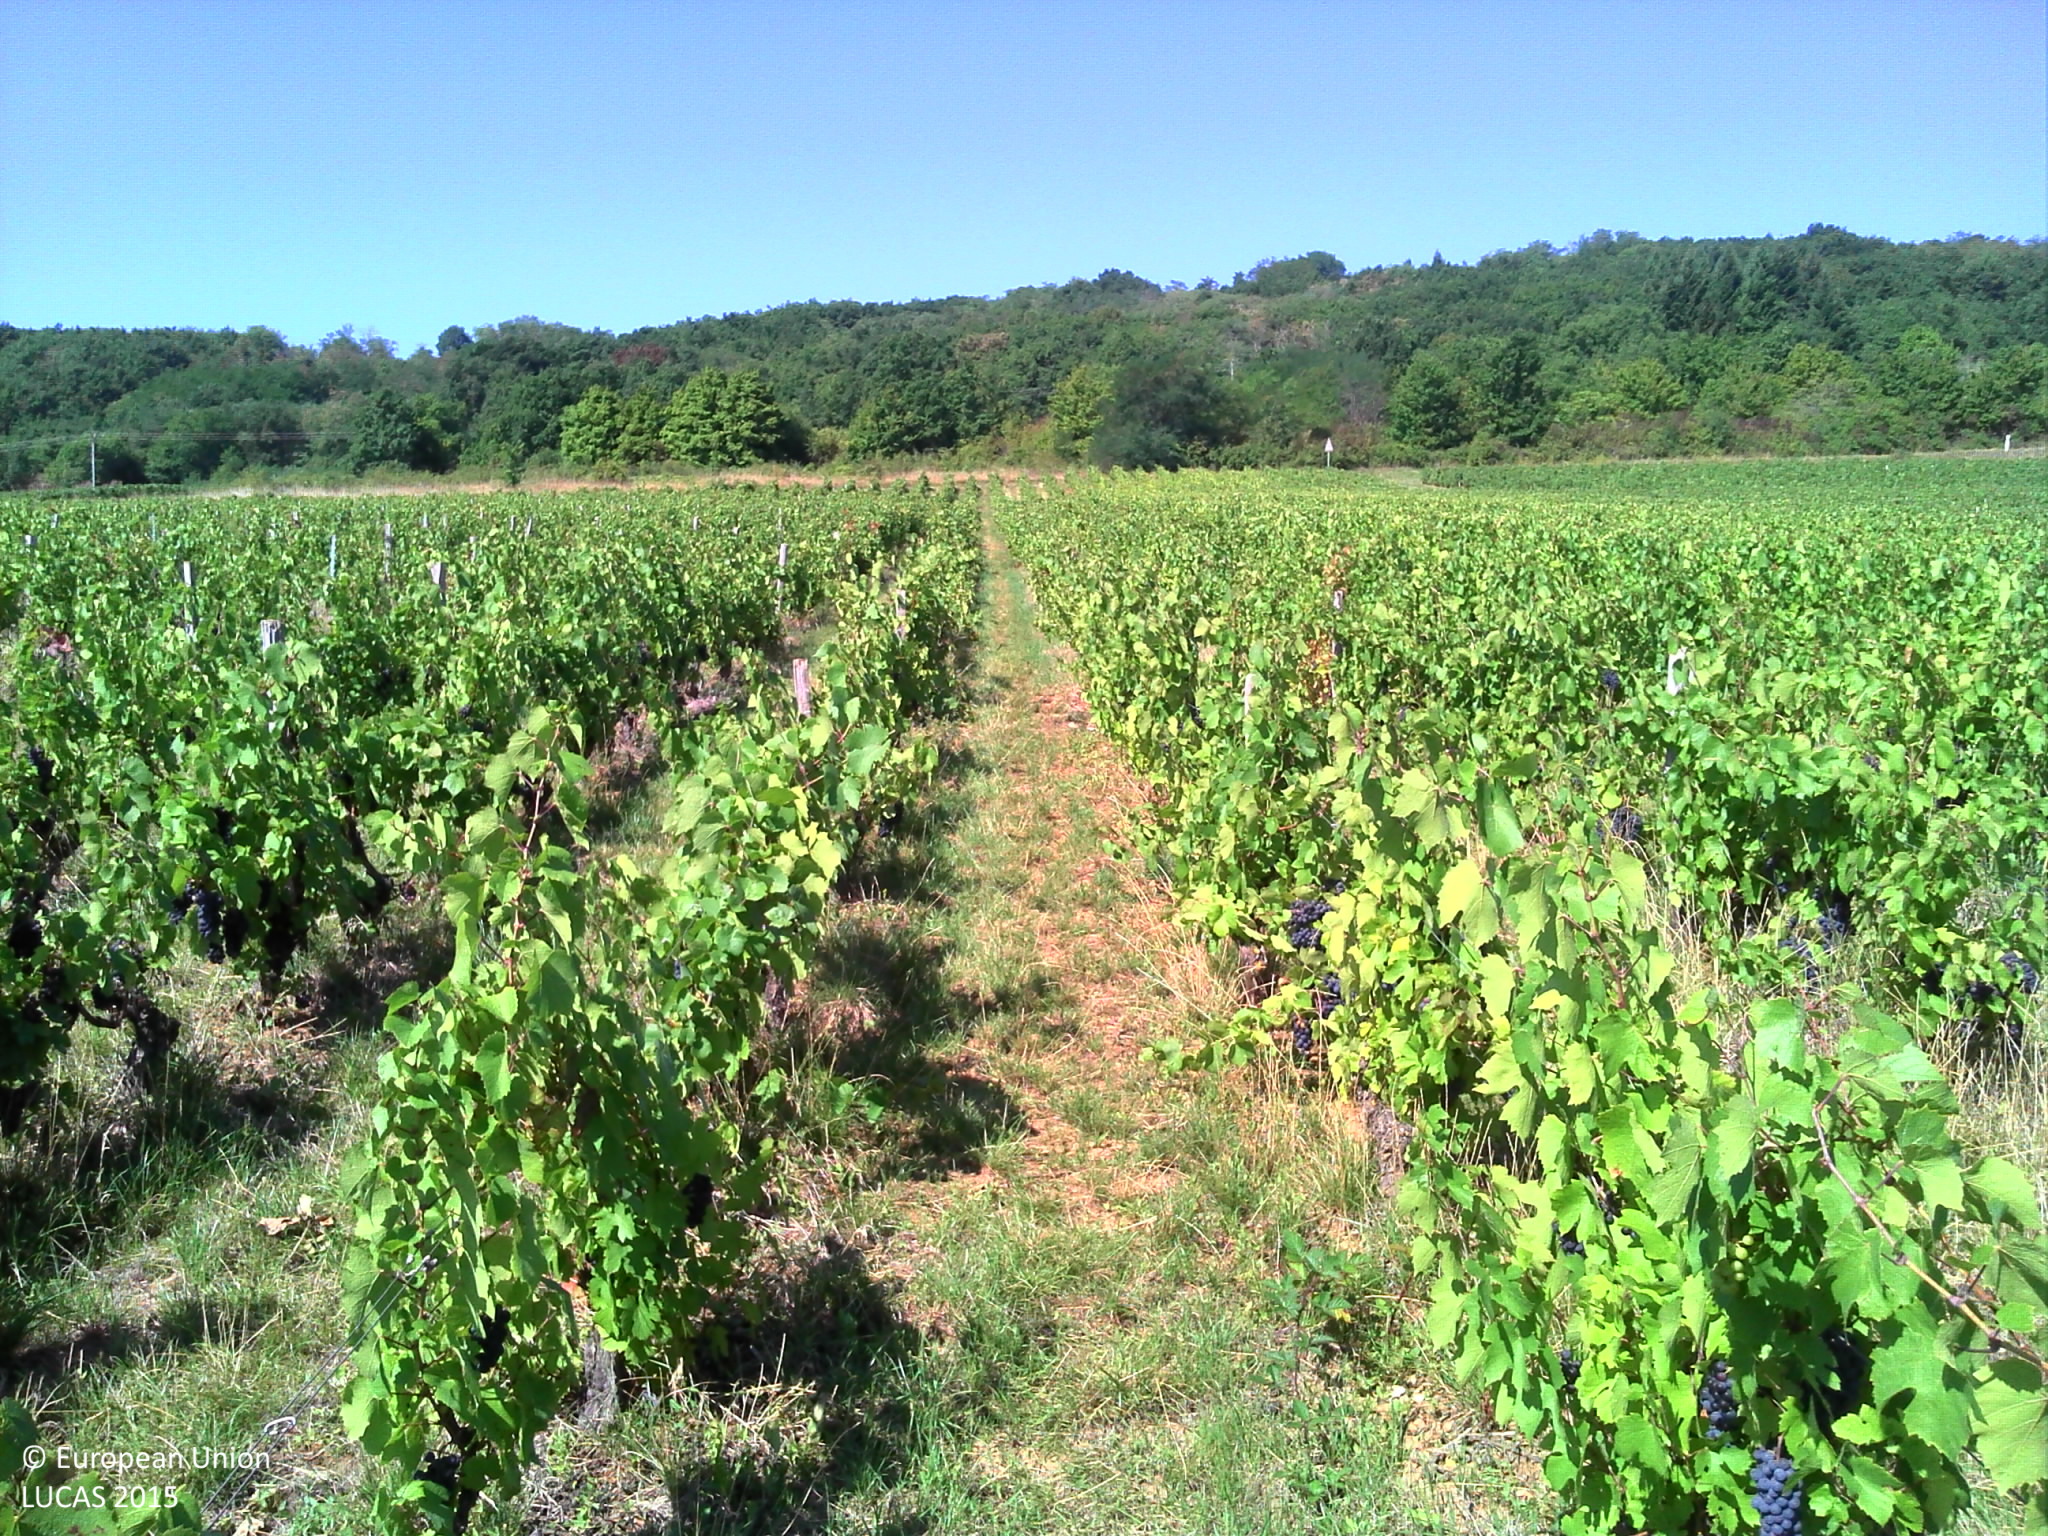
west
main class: Cropland
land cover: Vineyards
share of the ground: 50 - 75 %
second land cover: Grassland without tree/shrub cover
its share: 25 - 50 %
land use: Agriculture (excluding fallow land and kitchen gardens)
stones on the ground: 10 - 25 %
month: August
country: FR
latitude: 45.8939
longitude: 4.6804
